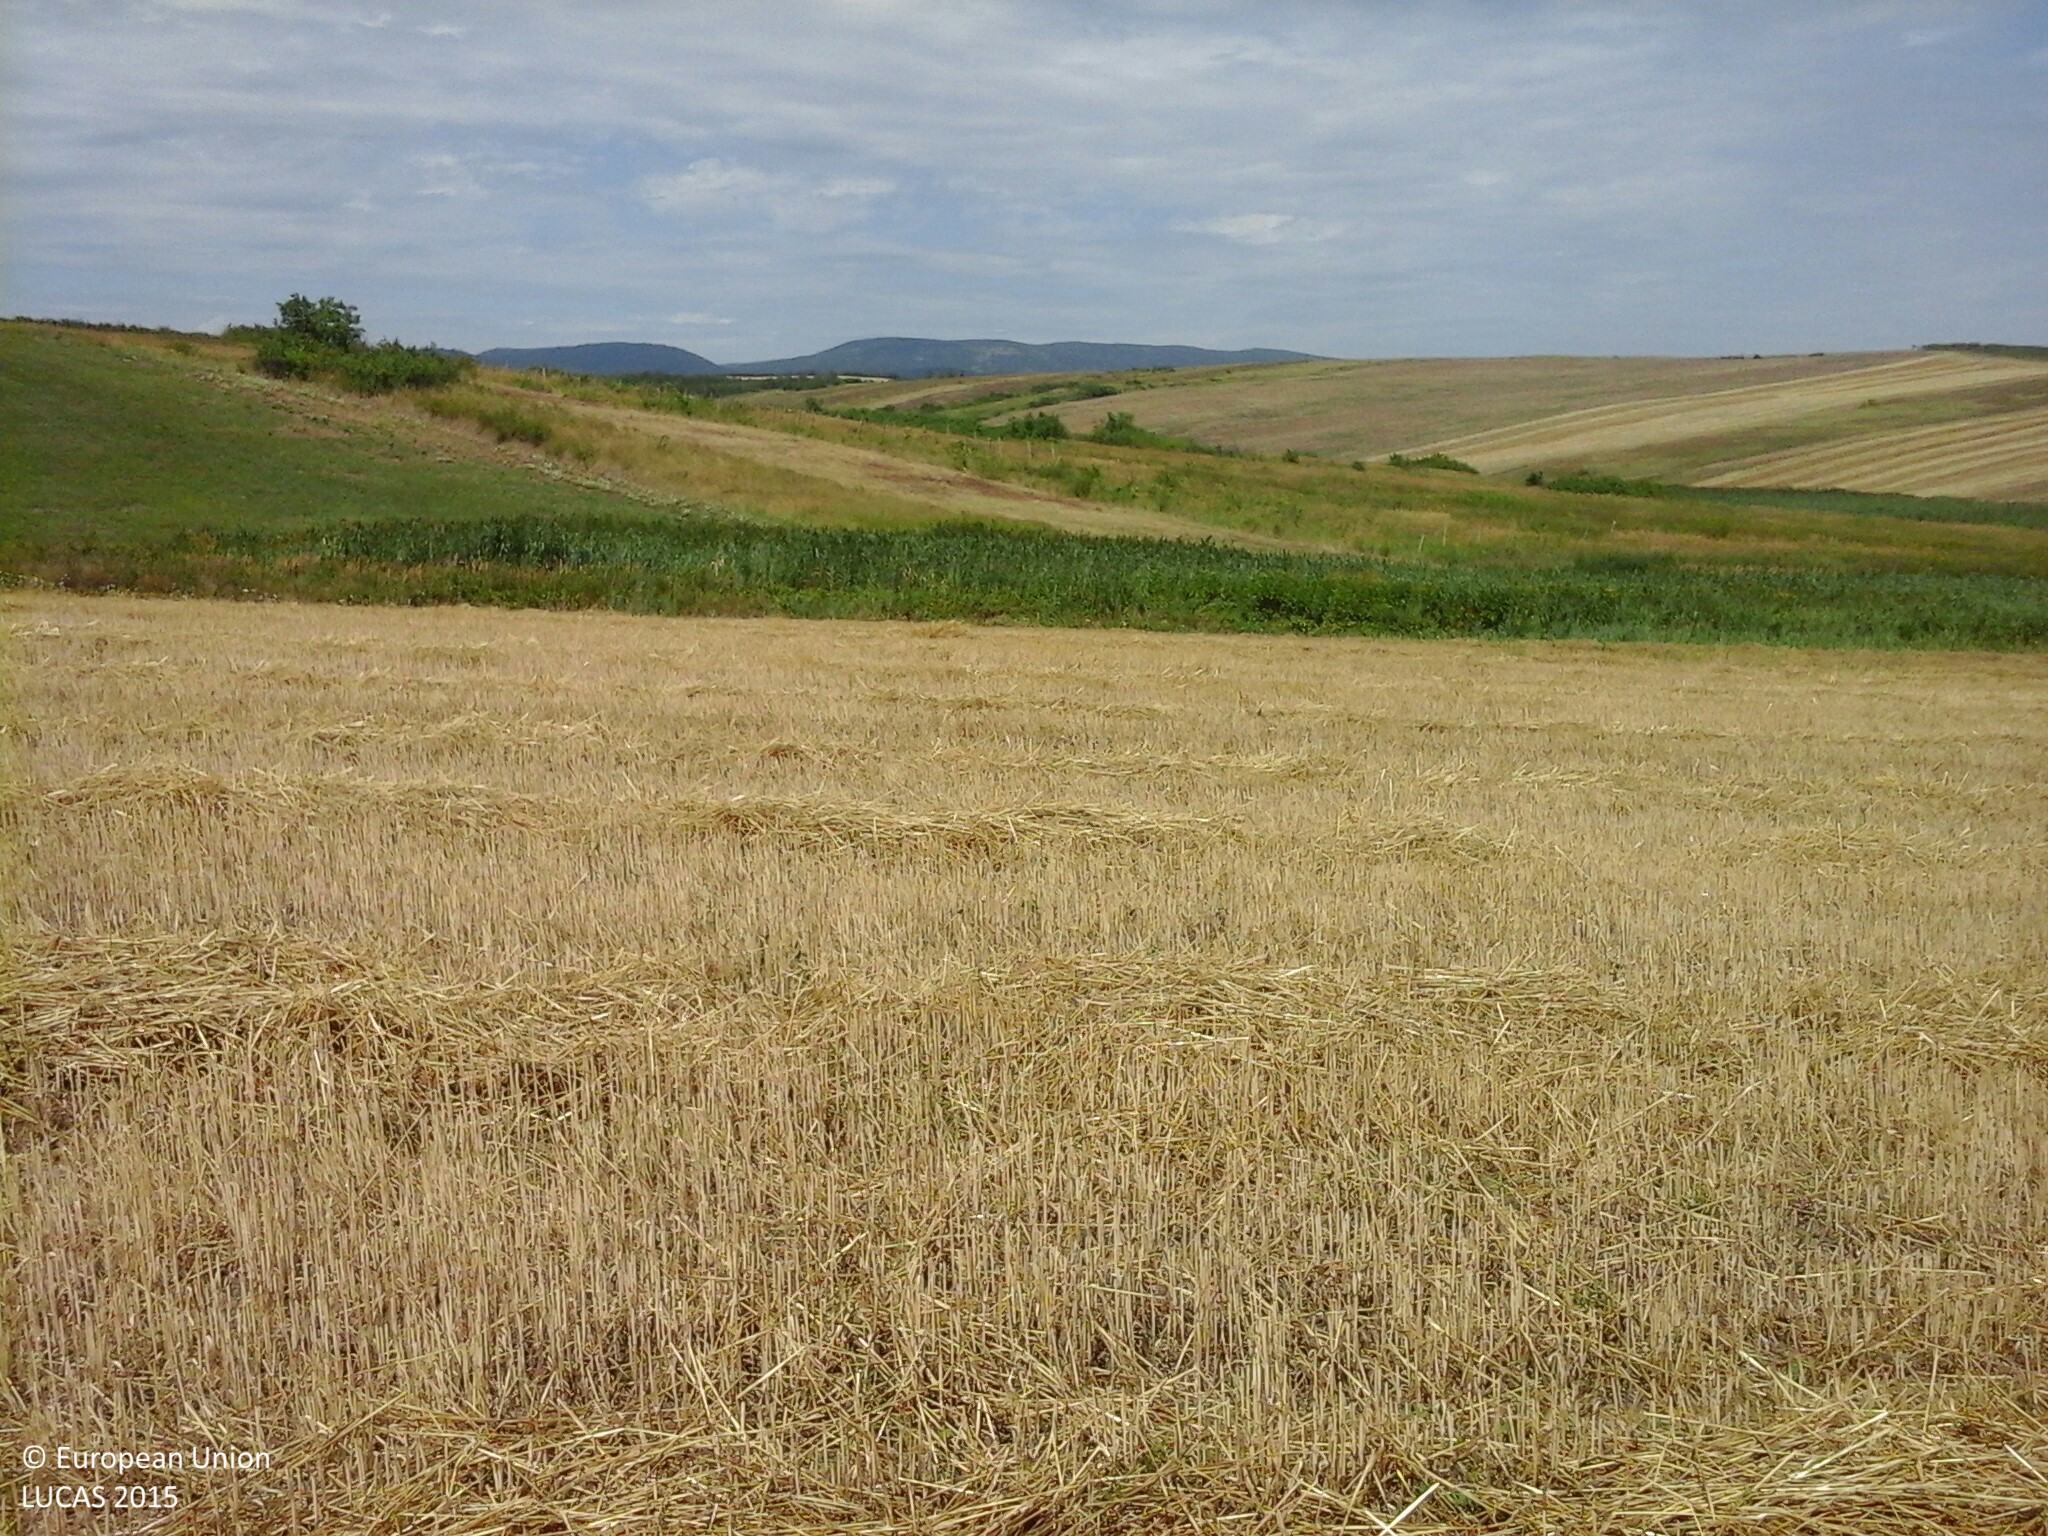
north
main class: Cropland
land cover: Common wheat
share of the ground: 50 - 75 %
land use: Agriculture (excluding fallow land and kitchen gardens)
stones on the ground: < 10 %
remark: Harvested field
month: July
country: HU
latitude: 47.9420
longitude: 20.6509
